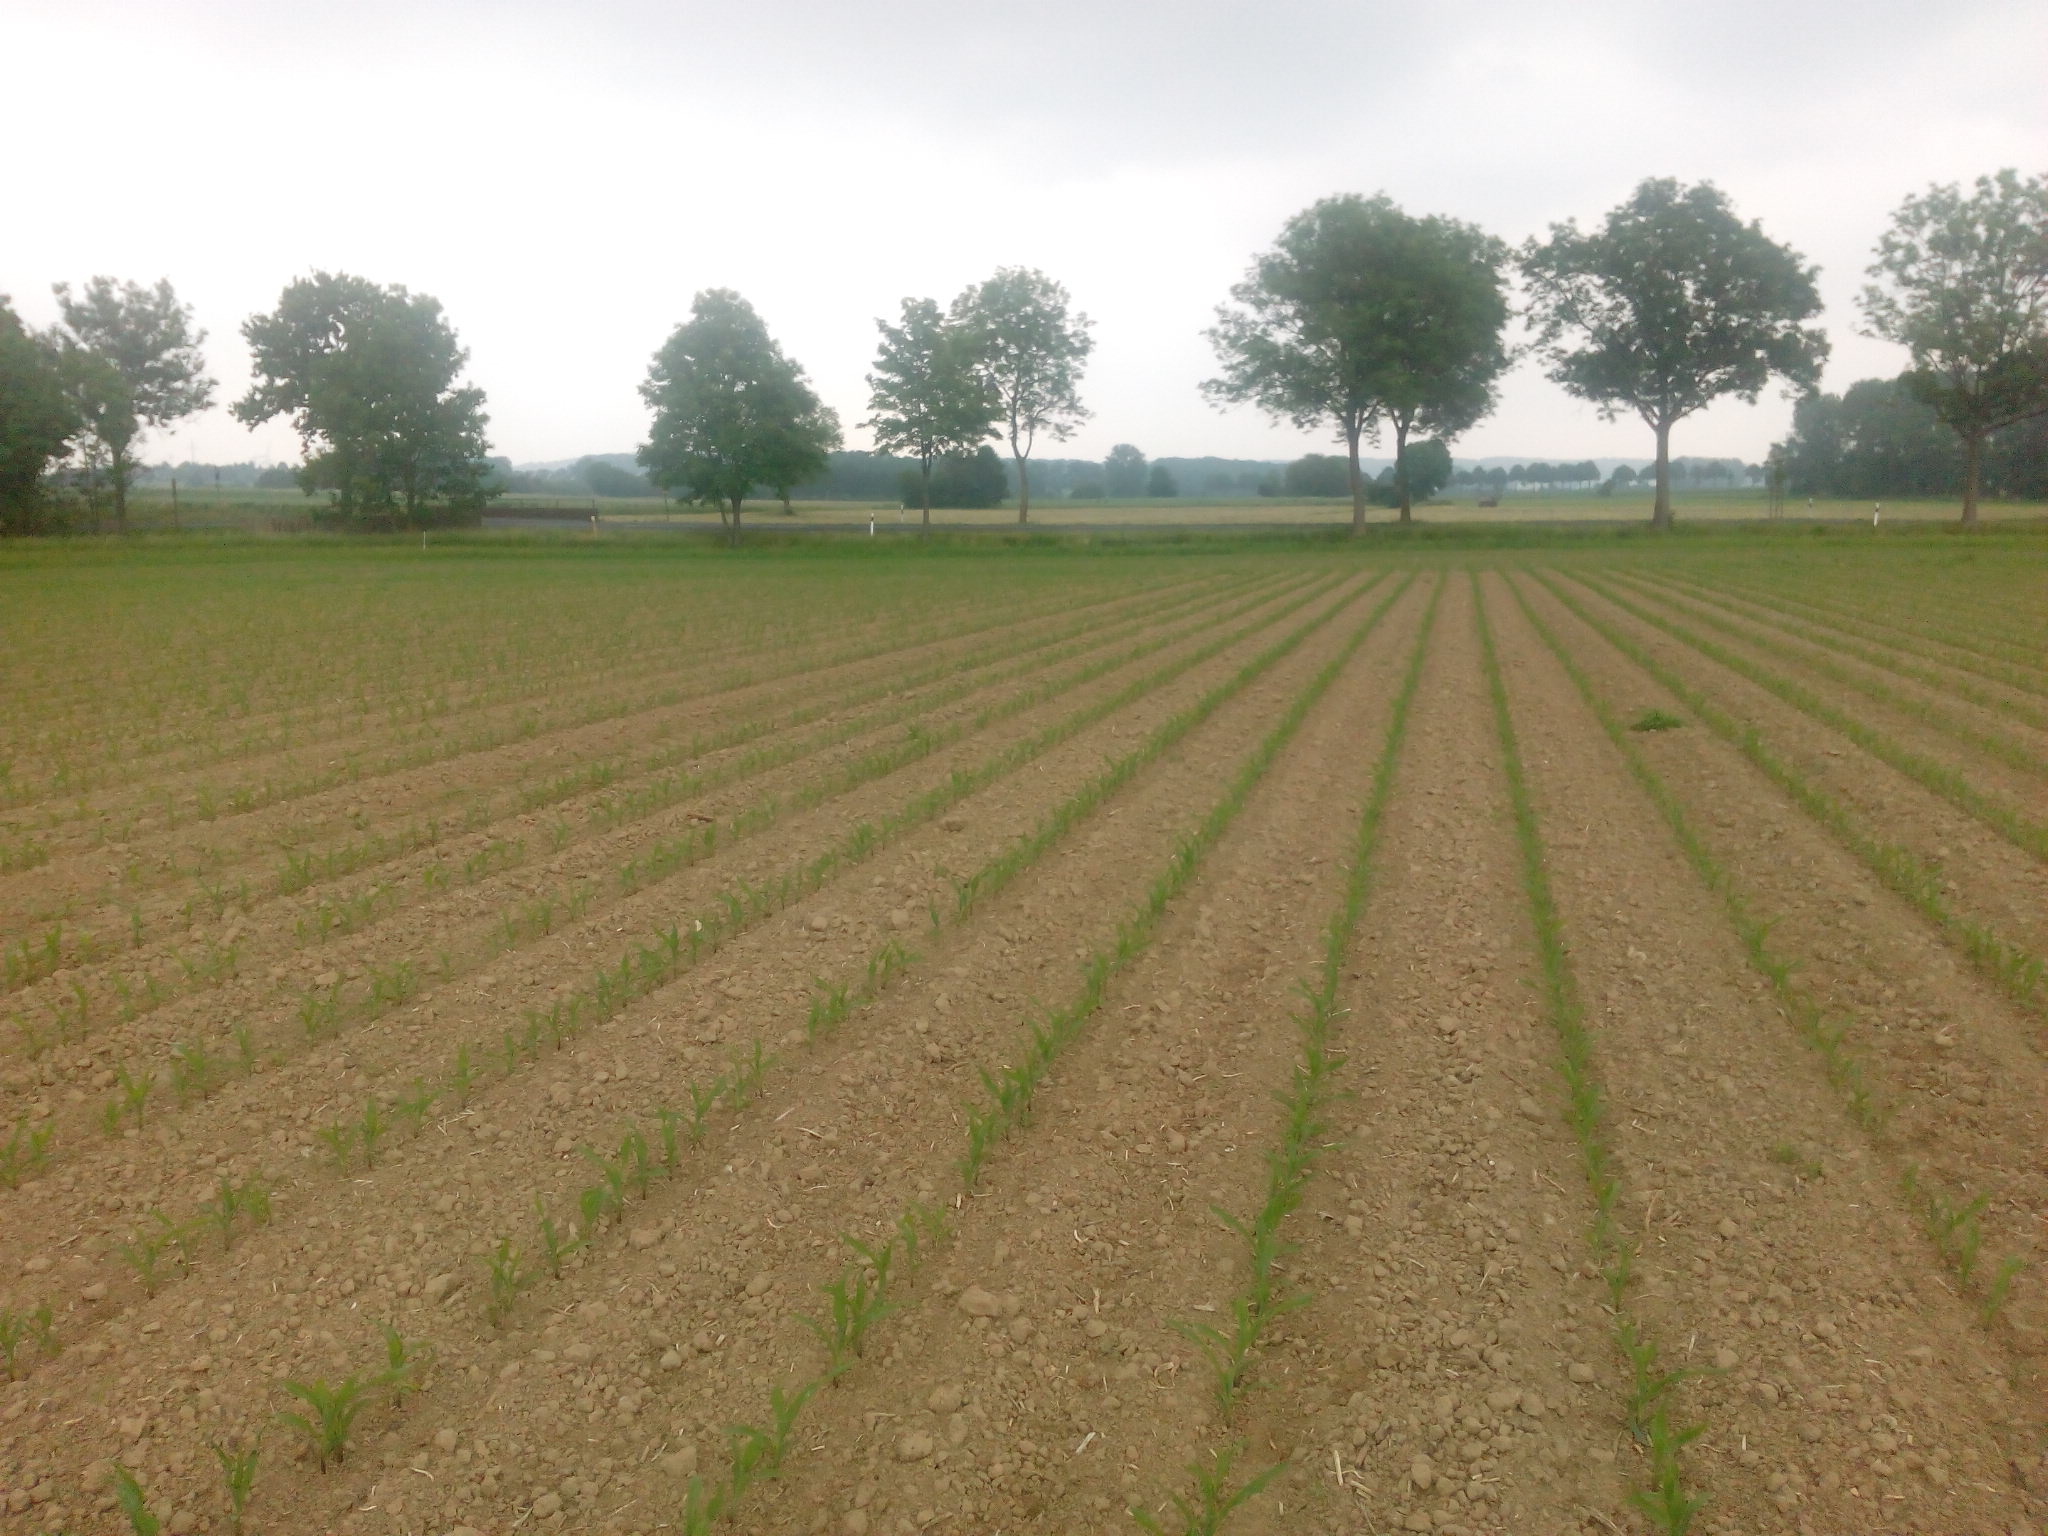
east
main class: Cropland
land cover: Maize
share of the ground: > 75 %
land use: Agriculture (excluding fallow land and kitchen gardens)
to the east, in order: Maize; Ditches and canals; Lines of trees; Paved roads, cycling and walking lanes; Lines of trees; Grassland without tree/shrub cover
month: June
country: DE
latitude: 52.1972
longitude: 9.6344
